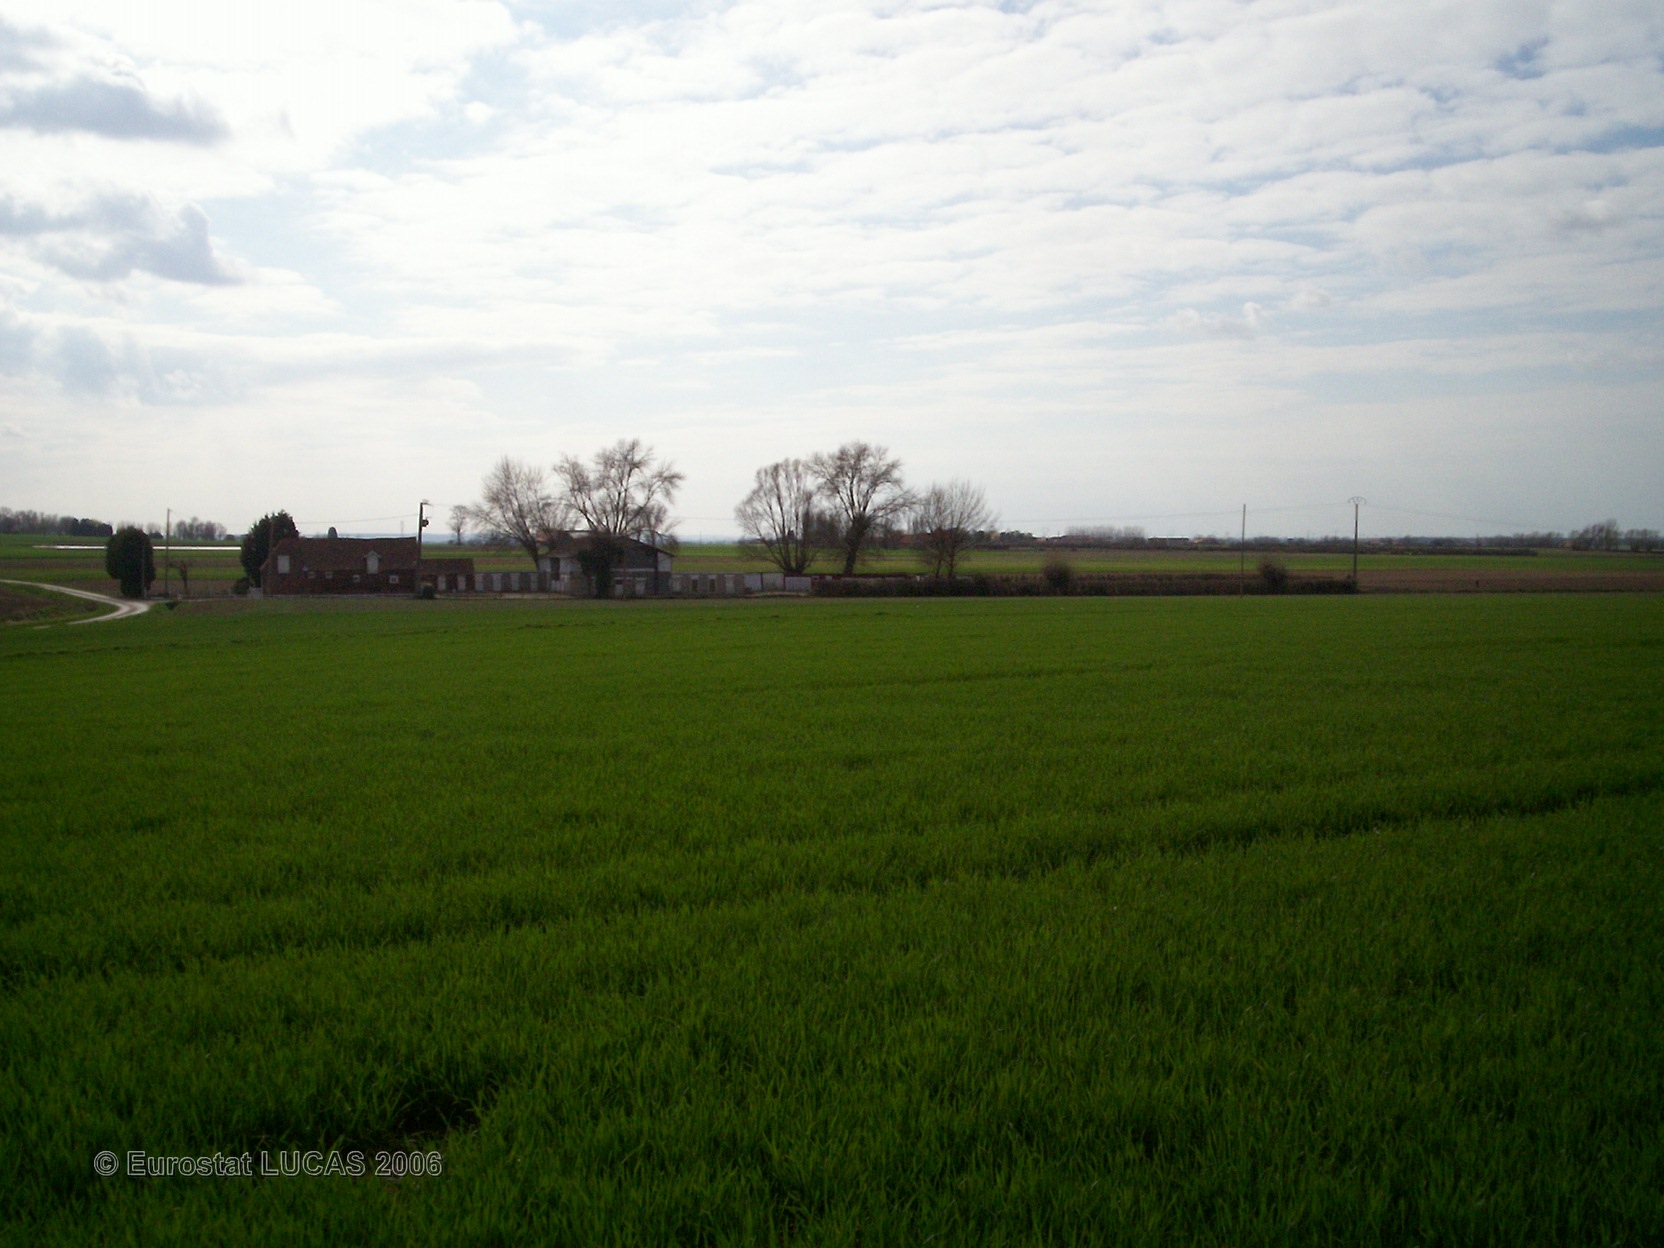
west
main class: Cropland
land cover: Common wheat
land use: Agriculture (excluding fallow land and kitchen gardens)
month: April
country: FR
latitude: 50.8846
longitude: 2.3532
